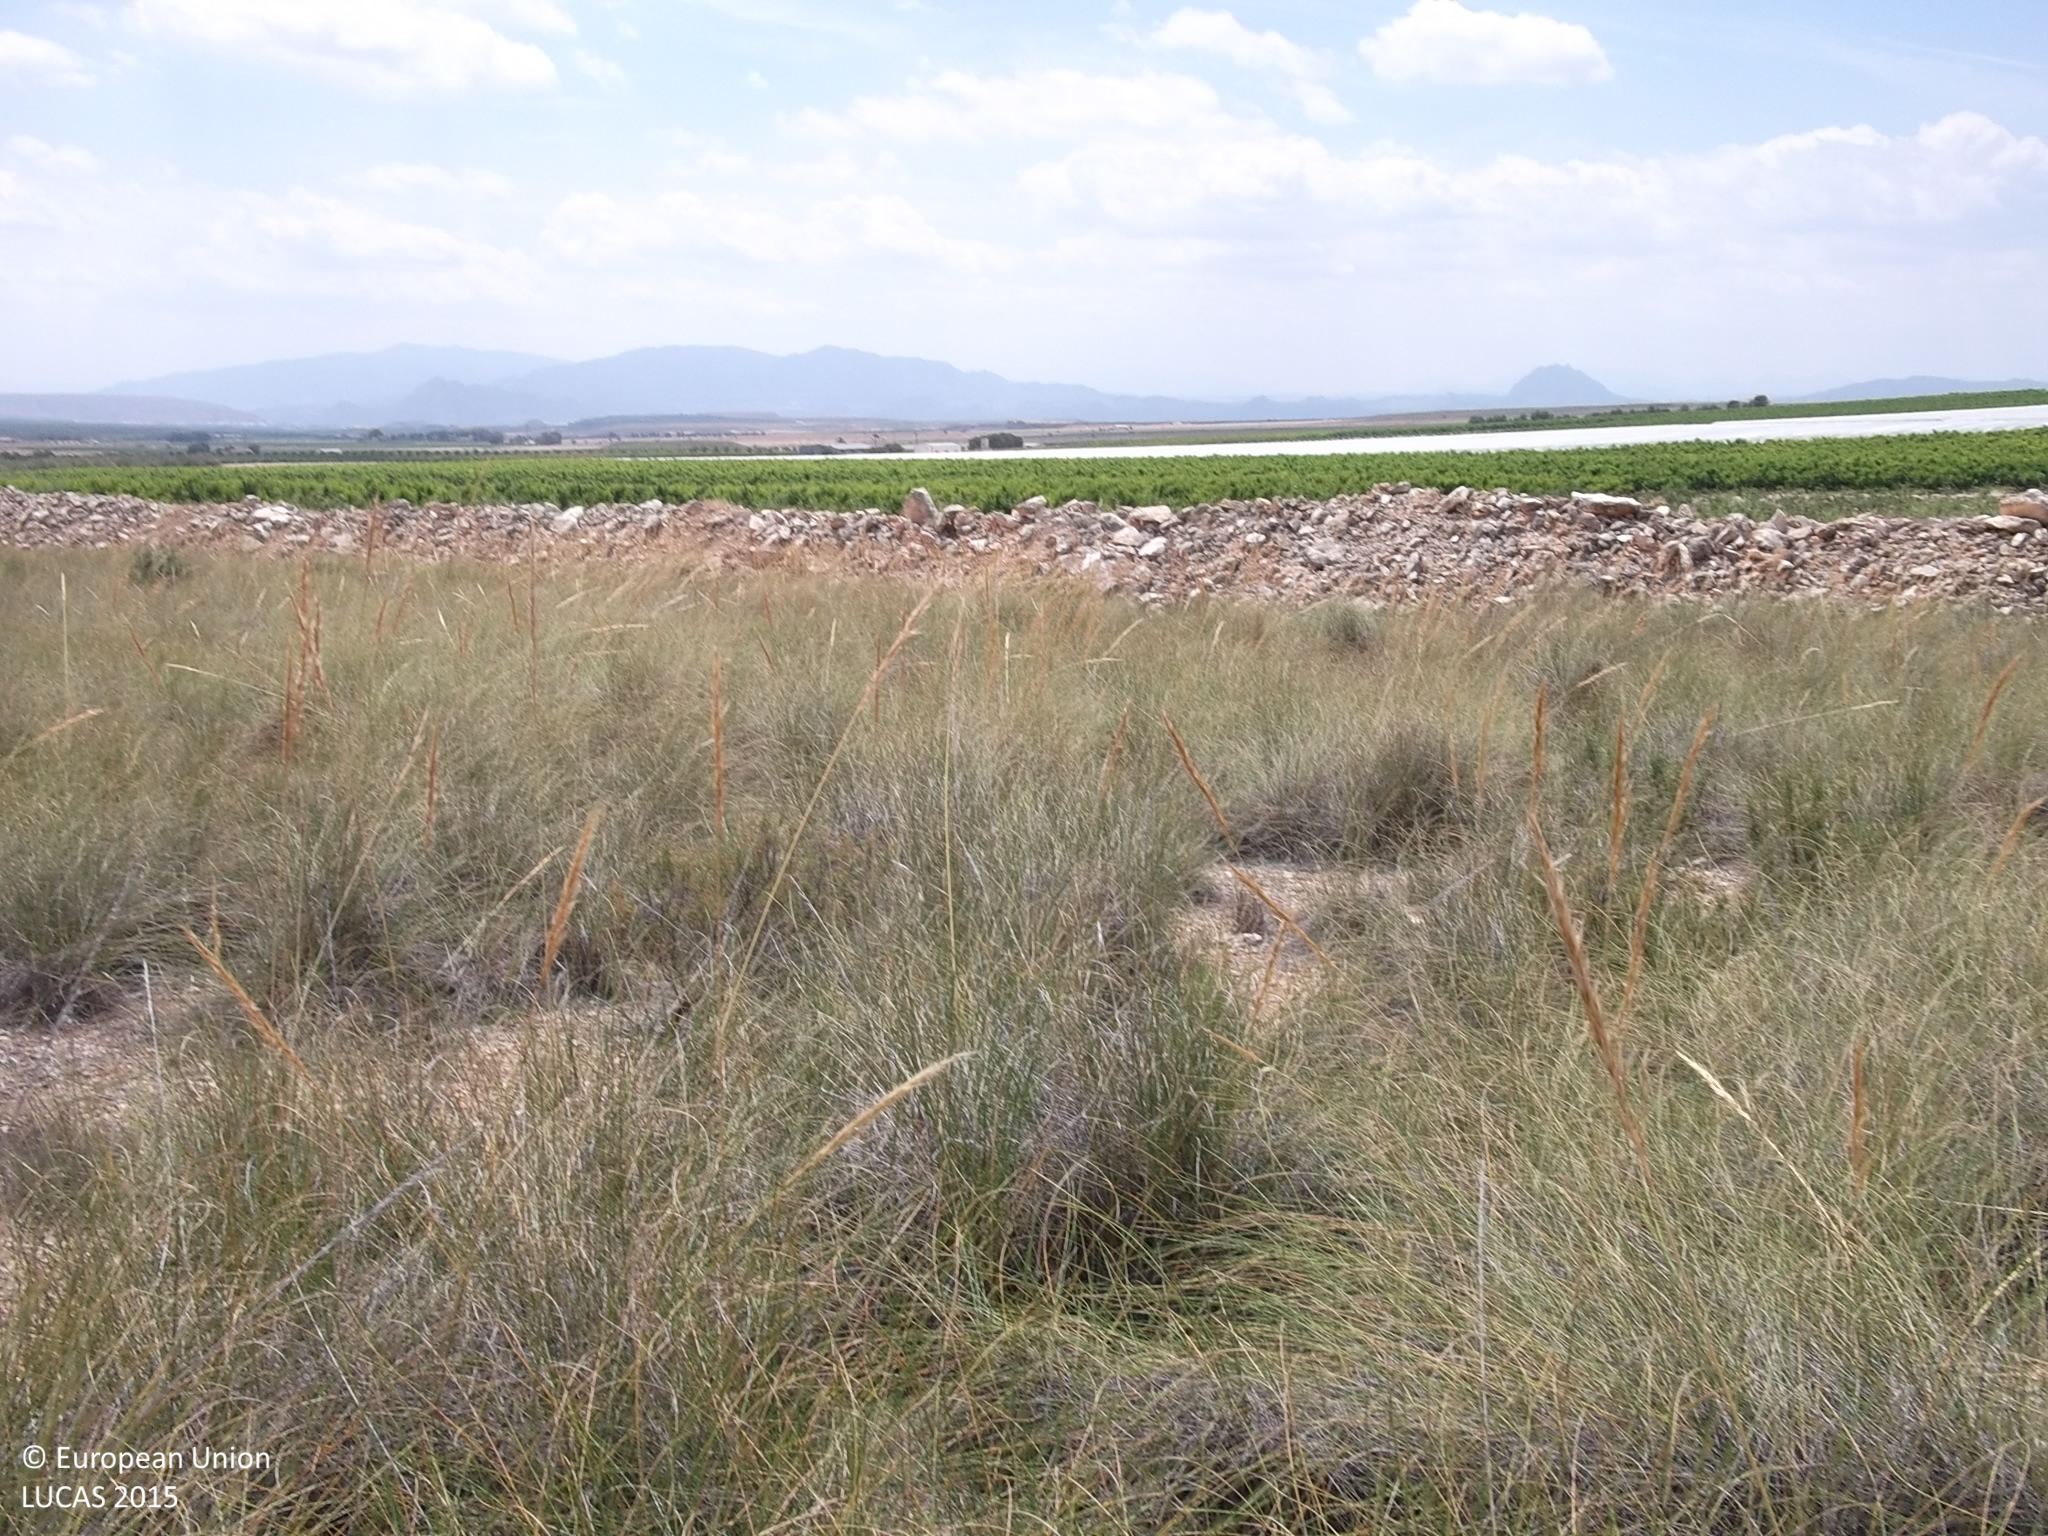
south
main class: Shrubland
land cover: Shrubland without tree cover
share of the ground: 25 - 50 %
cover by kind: shrubs 40 %, herbaceous plants 40 %, consolidated bare surface 20 %
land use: Semi-natural and natural areas not in use
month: May
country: ES
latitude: 38.3888
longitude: -1.4506
